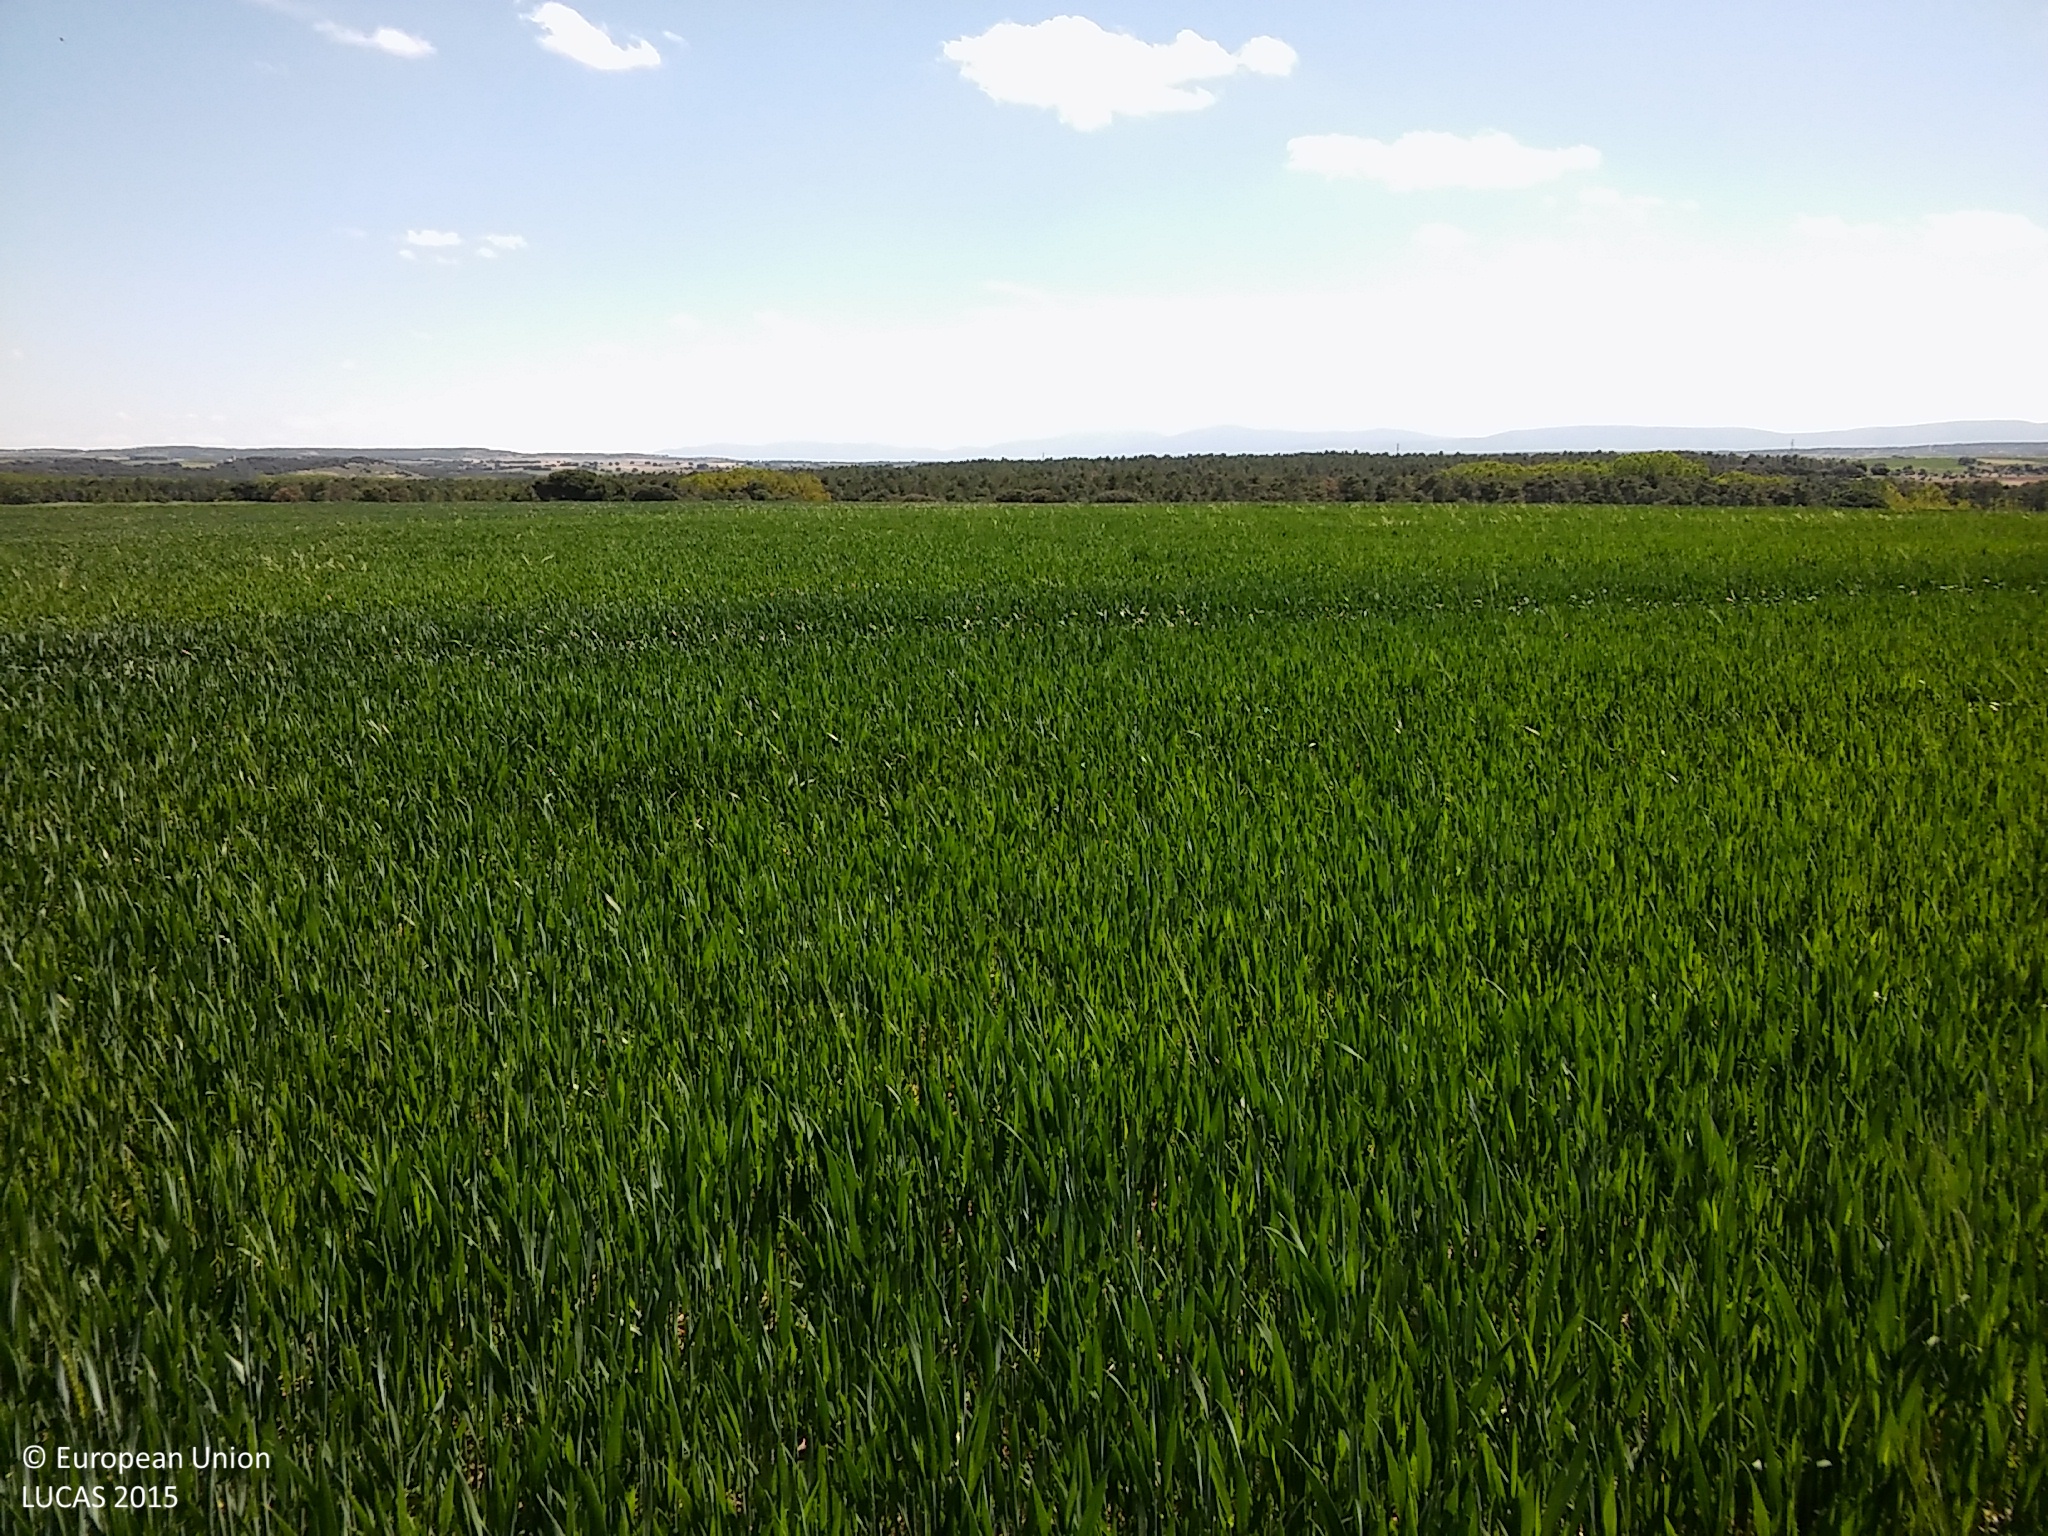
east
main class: Cropland
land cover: Common wheat
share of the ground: > 75 %
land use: Agriculture (excluding fallow land and kitchen gardens)
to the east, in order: Common wheat
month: May
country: ES
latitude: 41.1870
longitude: -3.9643
